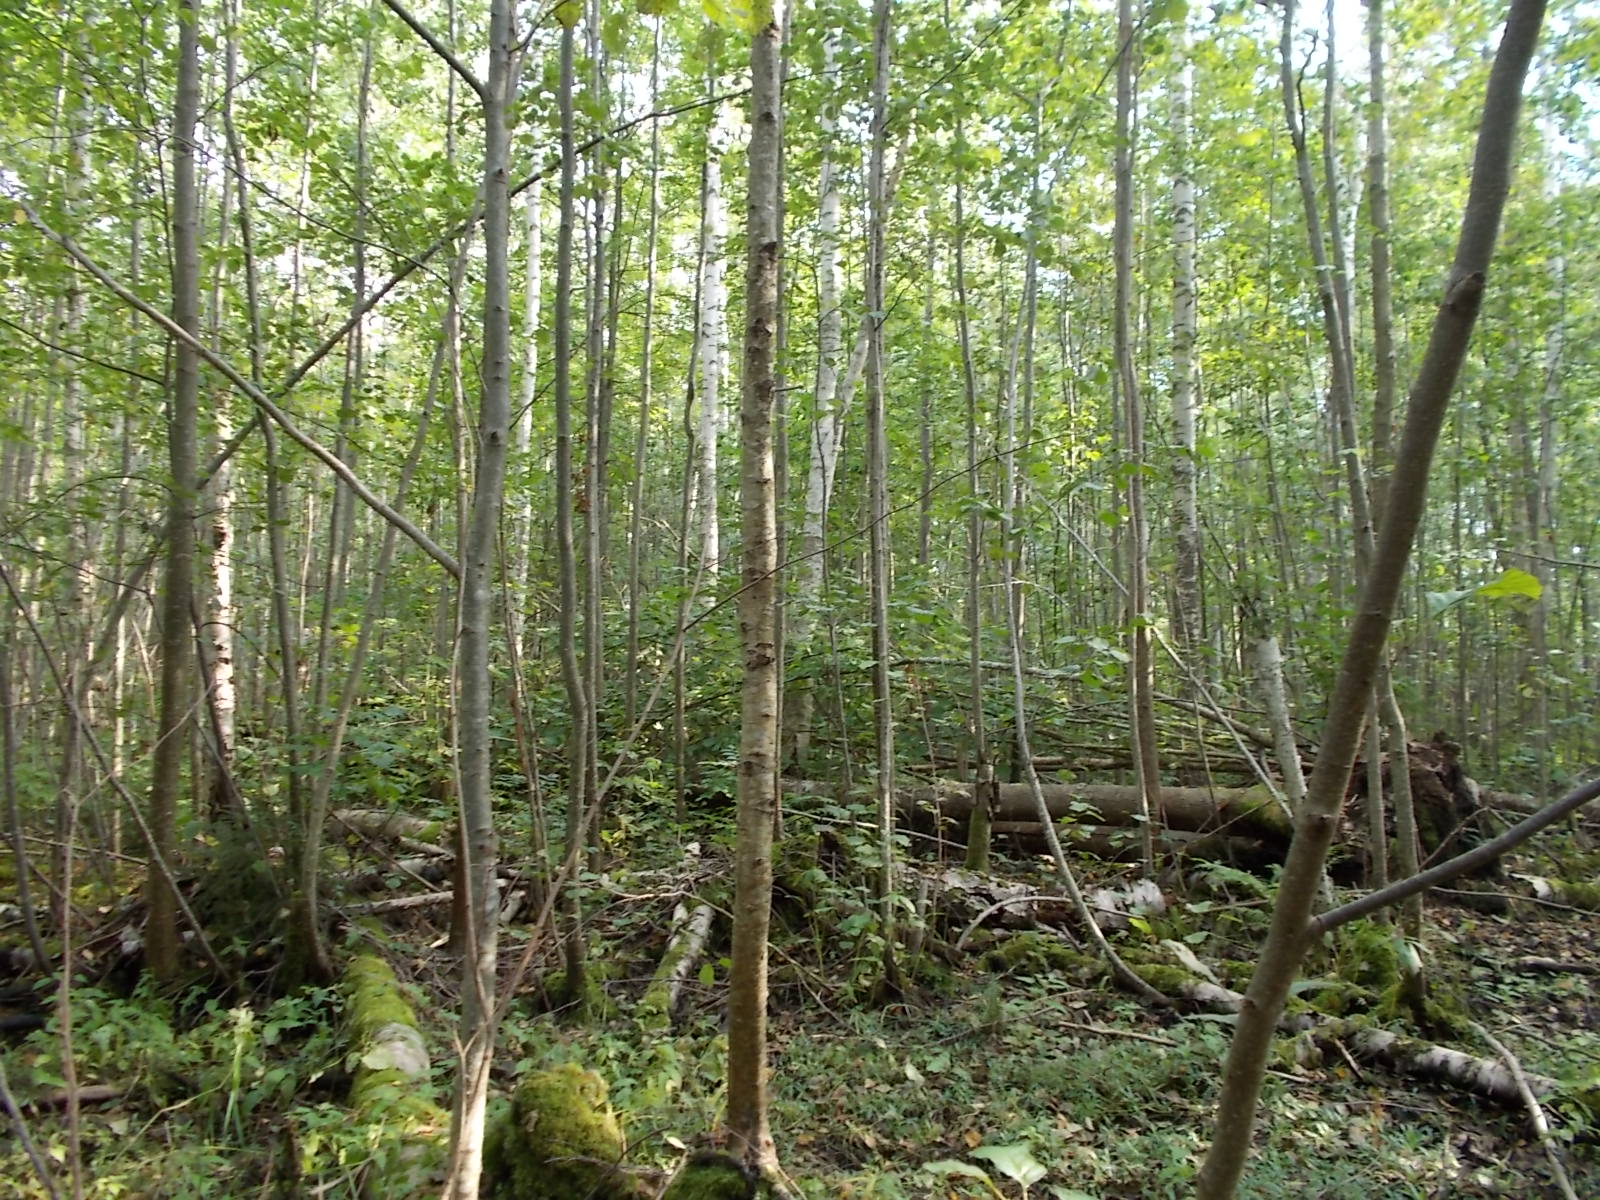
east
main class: Woodland
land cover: Broadleaved woodland
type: mire and swamp forests
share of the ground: > 75 %
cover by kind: broadleaved forest trees 90 %, herbaceous plants 10 %
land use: Forestry
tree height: > 5 m
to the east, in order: Broadleaved woodland
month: September
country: LV
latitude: 56.9245
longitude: 23.5629
